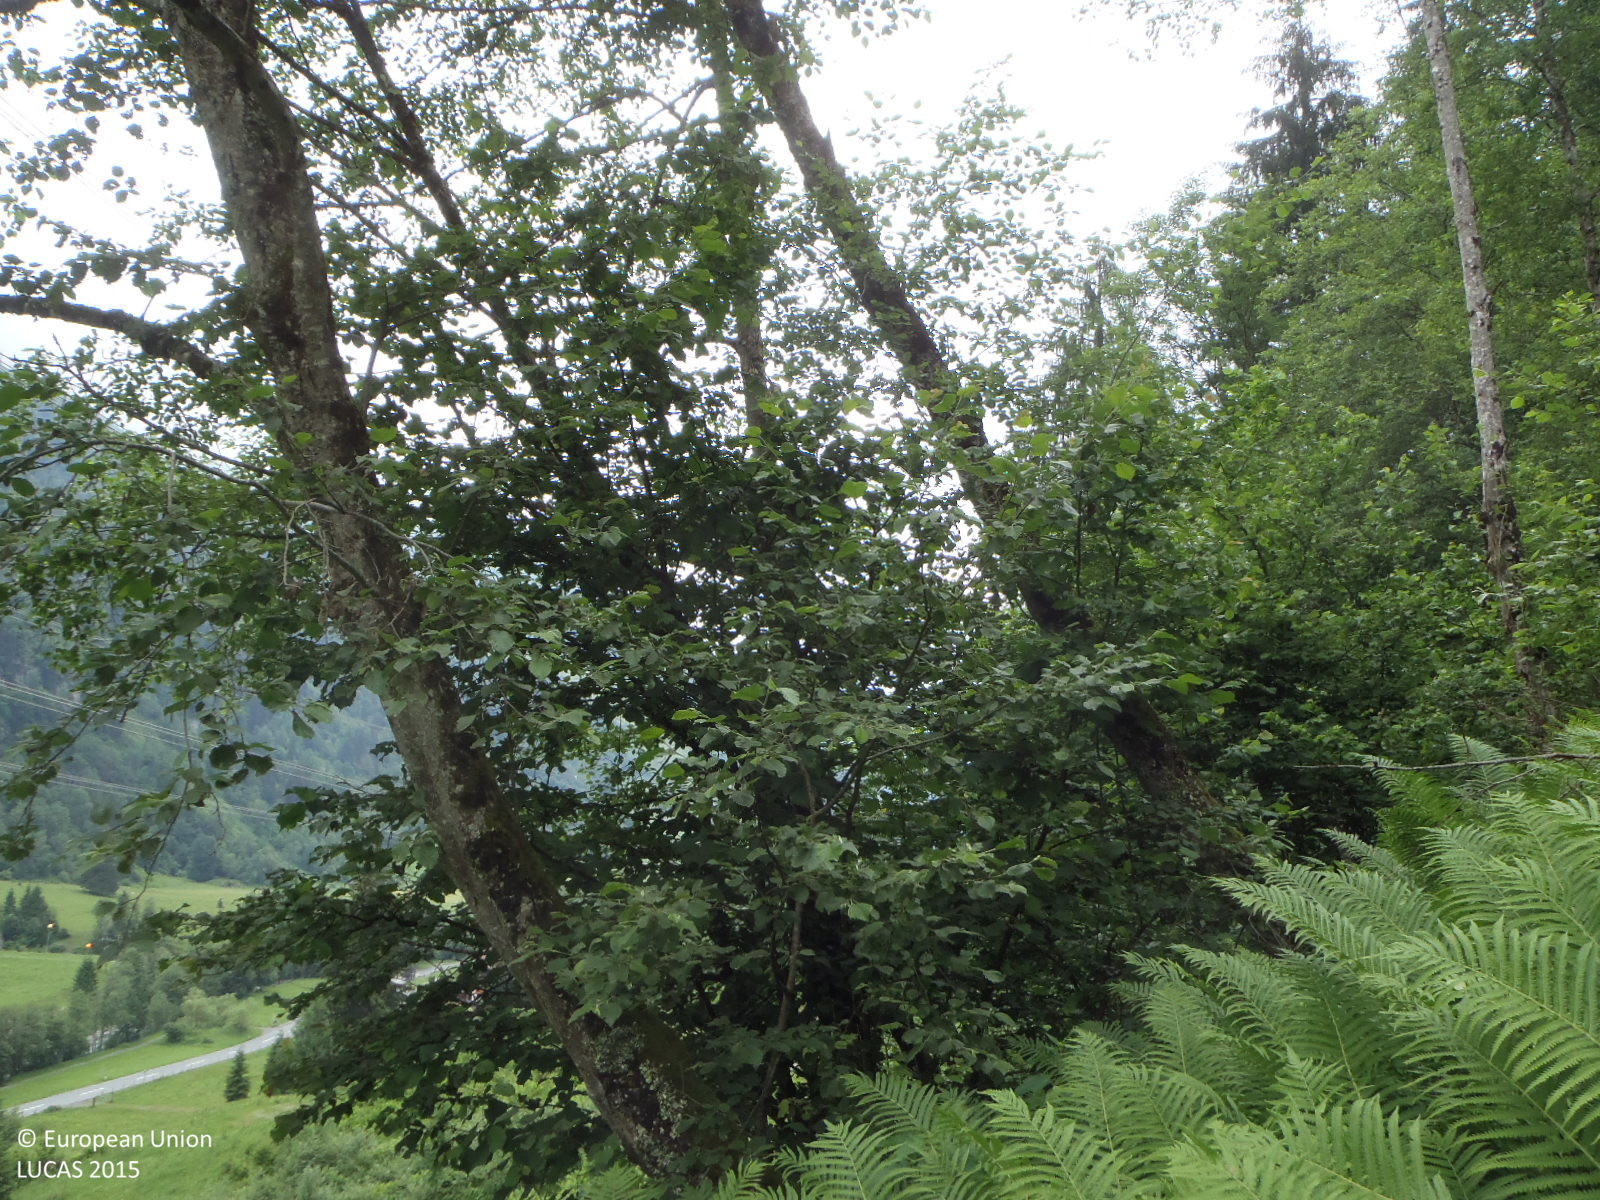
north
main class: Woodland
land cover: Broadleaved woodland
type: mountainous beech forest
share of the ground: 50 - 75 %
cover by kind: broadleaved forest trees 55 %, herbaceous plants 35 %, shrubs 10 %
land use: Forestry
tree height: > 5 m
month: June
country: AT
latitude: 47.2352
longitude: 12.7323
